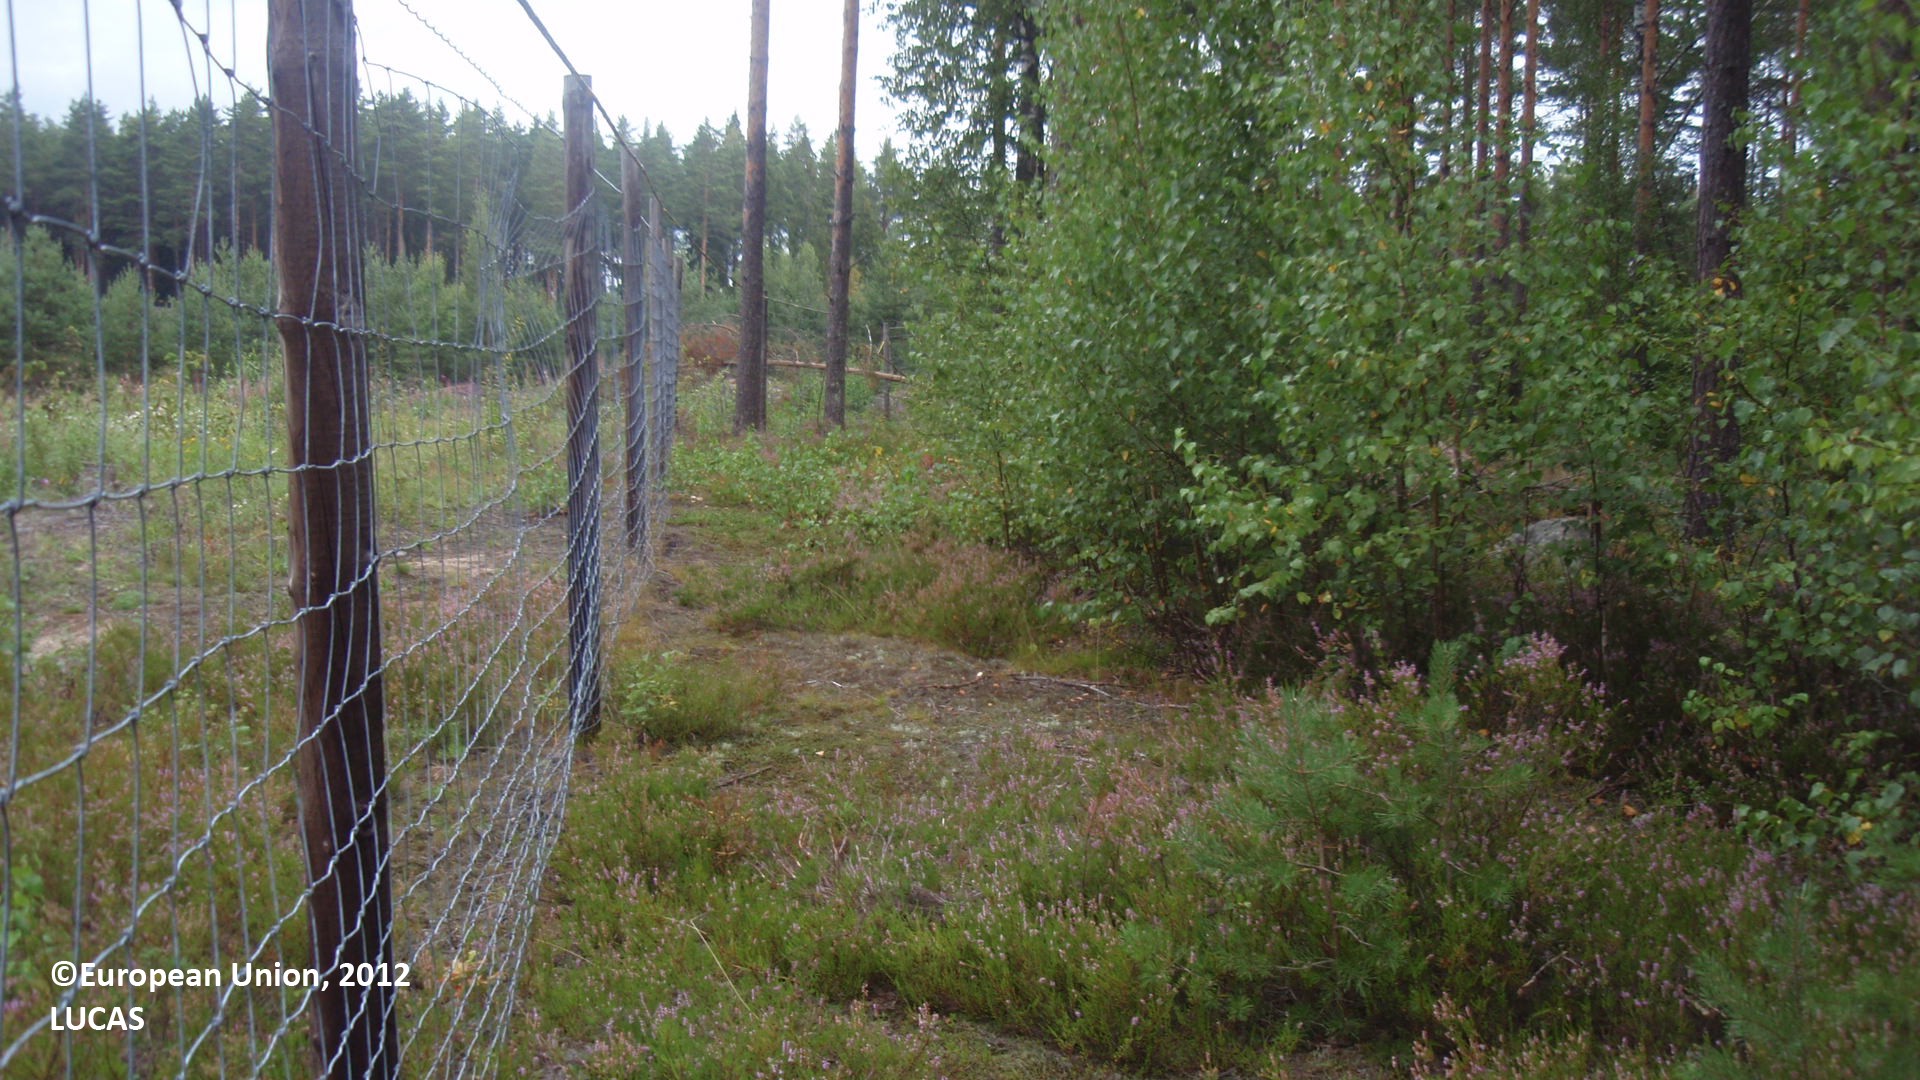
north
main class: Grassland
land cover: Grassland with sparse tree/shrub cover
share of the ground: > 75 %
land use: Abandoned areas
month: August
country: FI
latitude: 60.5683
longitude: 27.0850
